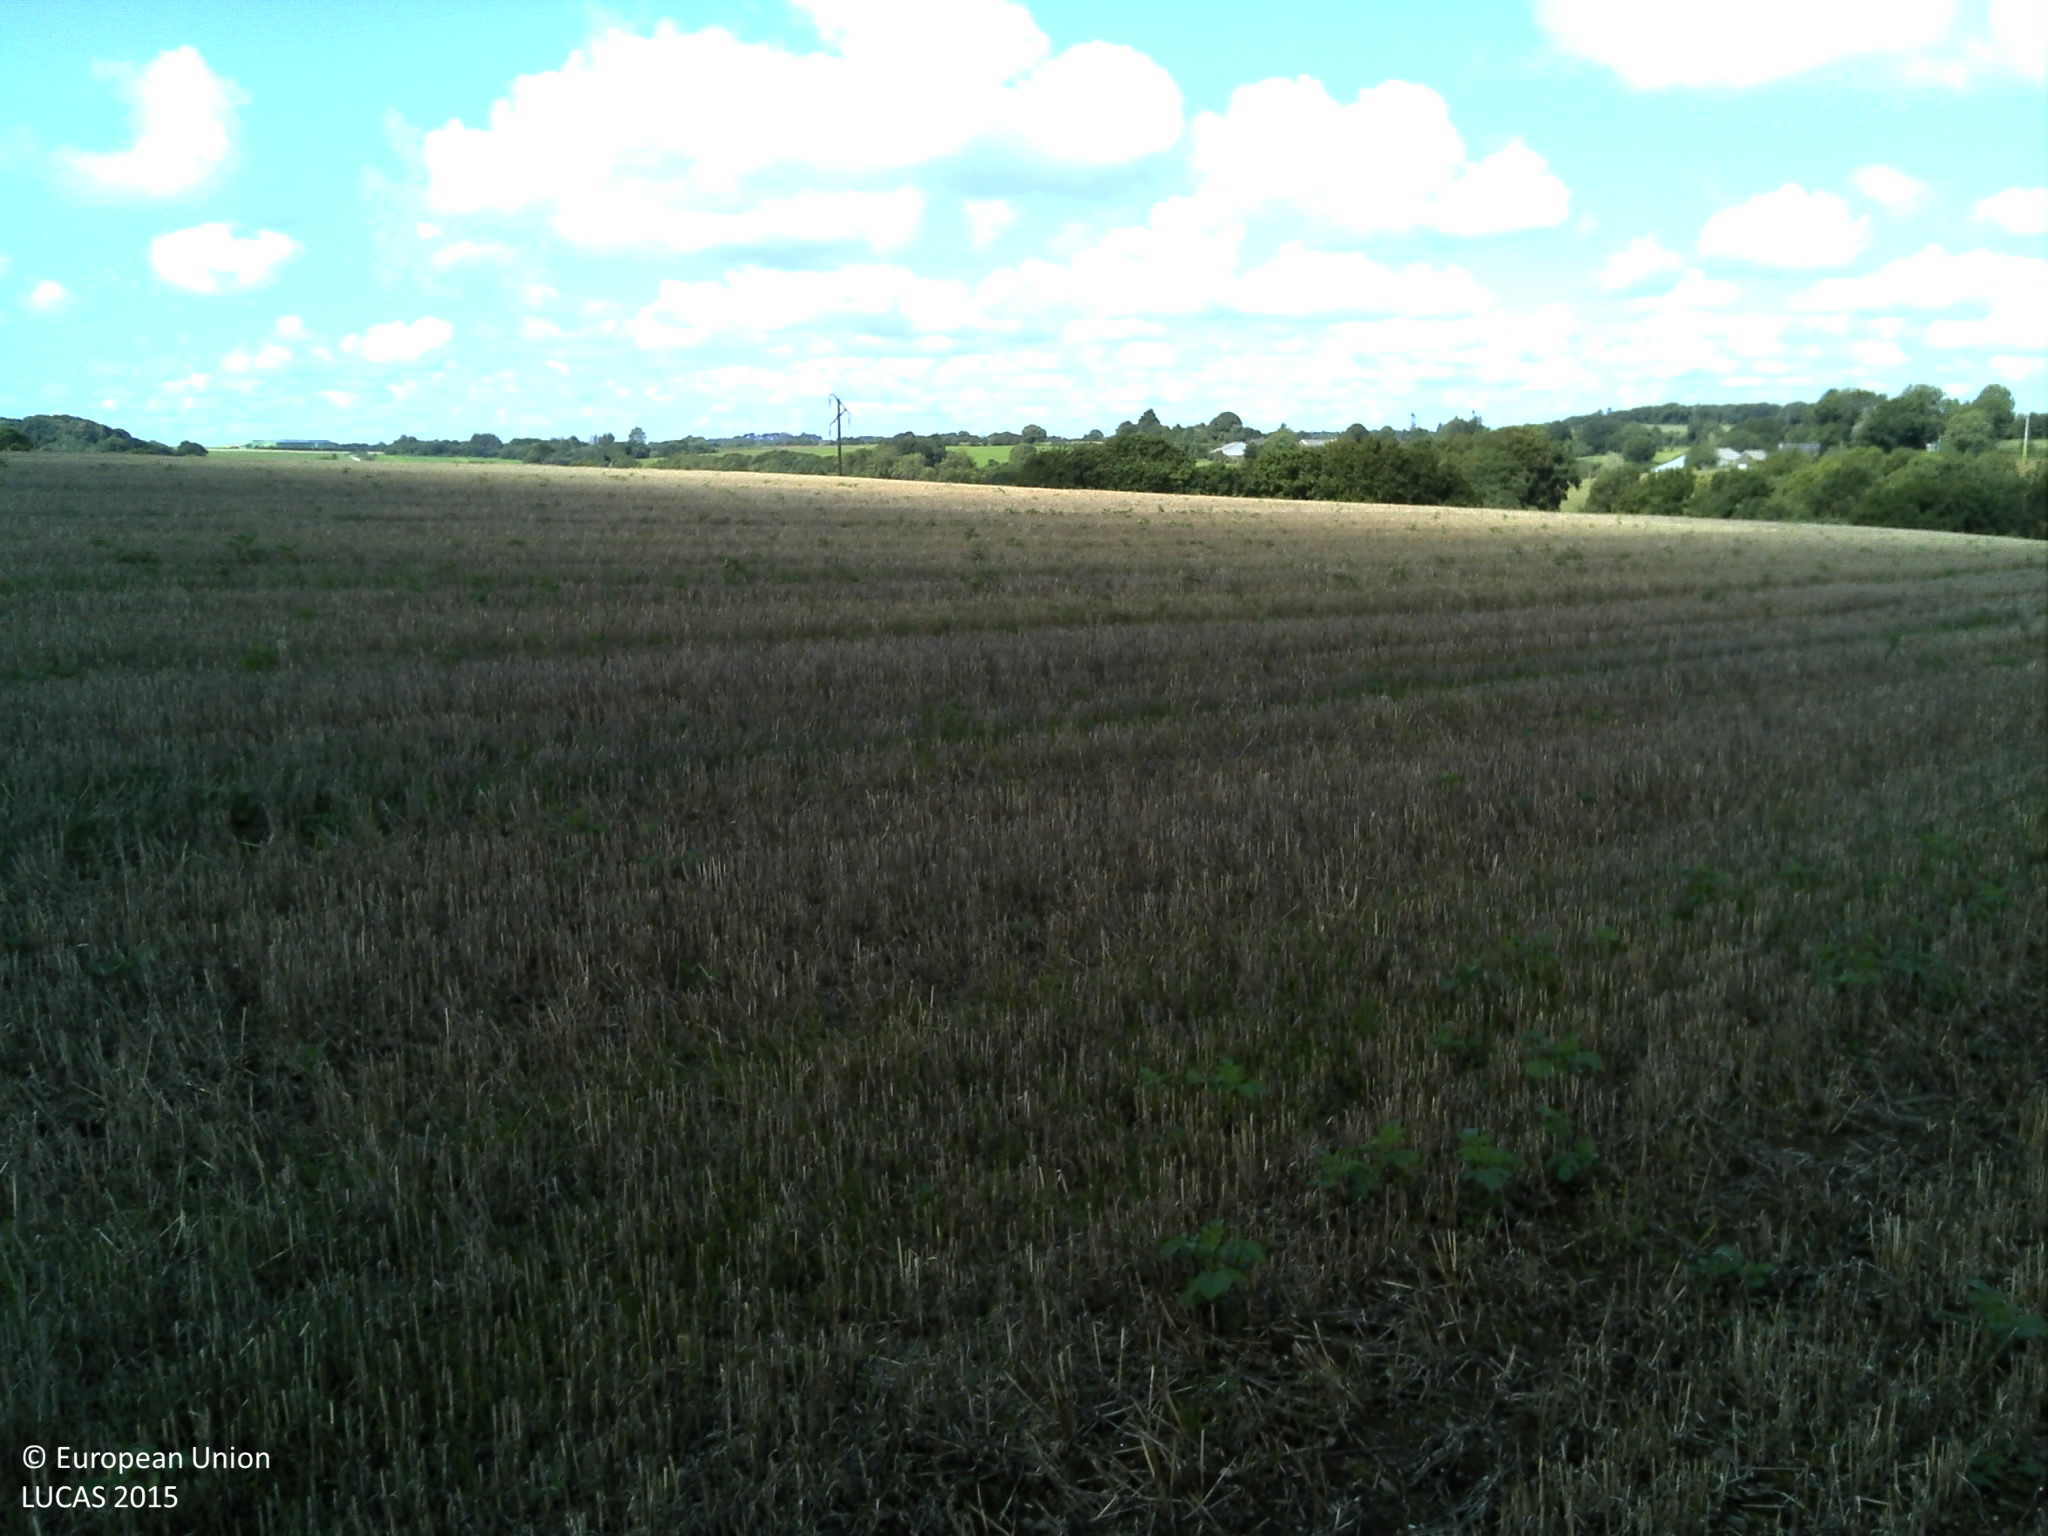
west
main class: Cropland
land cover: Durum wheat
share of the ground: > 75 %
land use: Agriculture (excluding fallow land and kitchen gardens)
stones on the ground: < 10 %
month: September
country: FR
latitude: 48.3620
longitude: -4.1690
